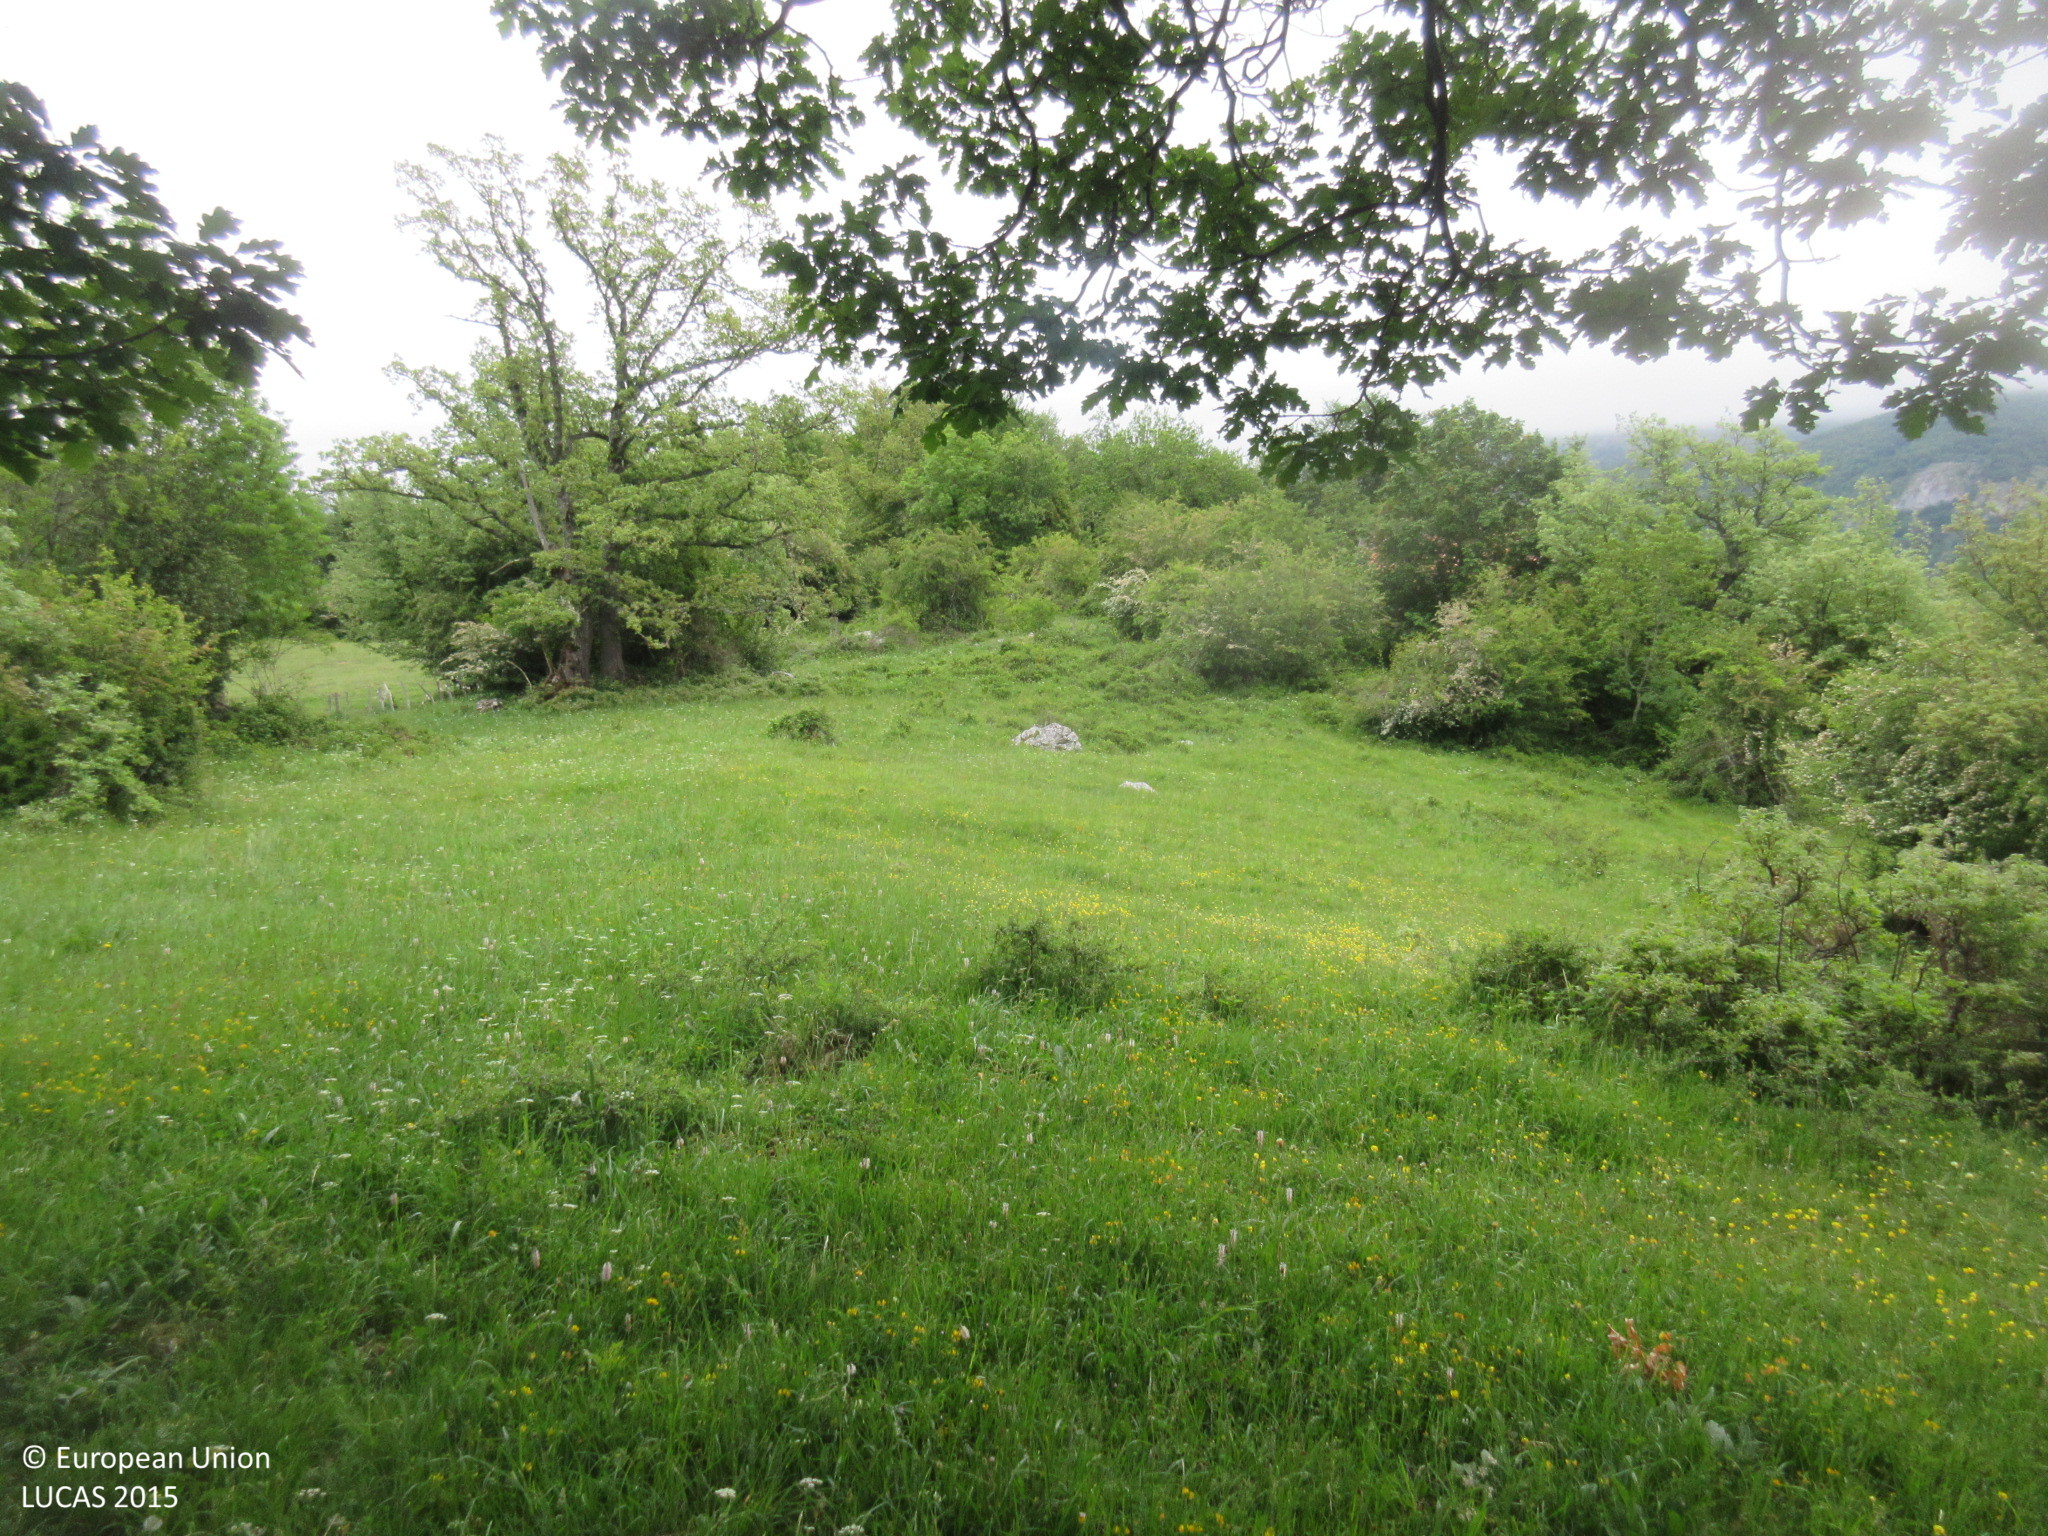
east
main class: Grassland
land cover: Grassland with sparse tree/shrub cover
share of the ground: > 75 %
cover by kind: herbaceous plants 90 %, broadleaved forest trees 5 %, shrubs 5 %
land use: Agriculture (excluding fallow land and kitchen gardens)
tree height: > 5 m
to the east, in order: Grassland with sparse tree/shrub cover; Broadleaved woodland; Artificial constructions in urban areas; Grassland with sparse tree/shrub cover; Dry stone walls; Fences; Broadleaved woodland
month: June
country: ES
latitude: 43.0609
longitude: -4.5595
